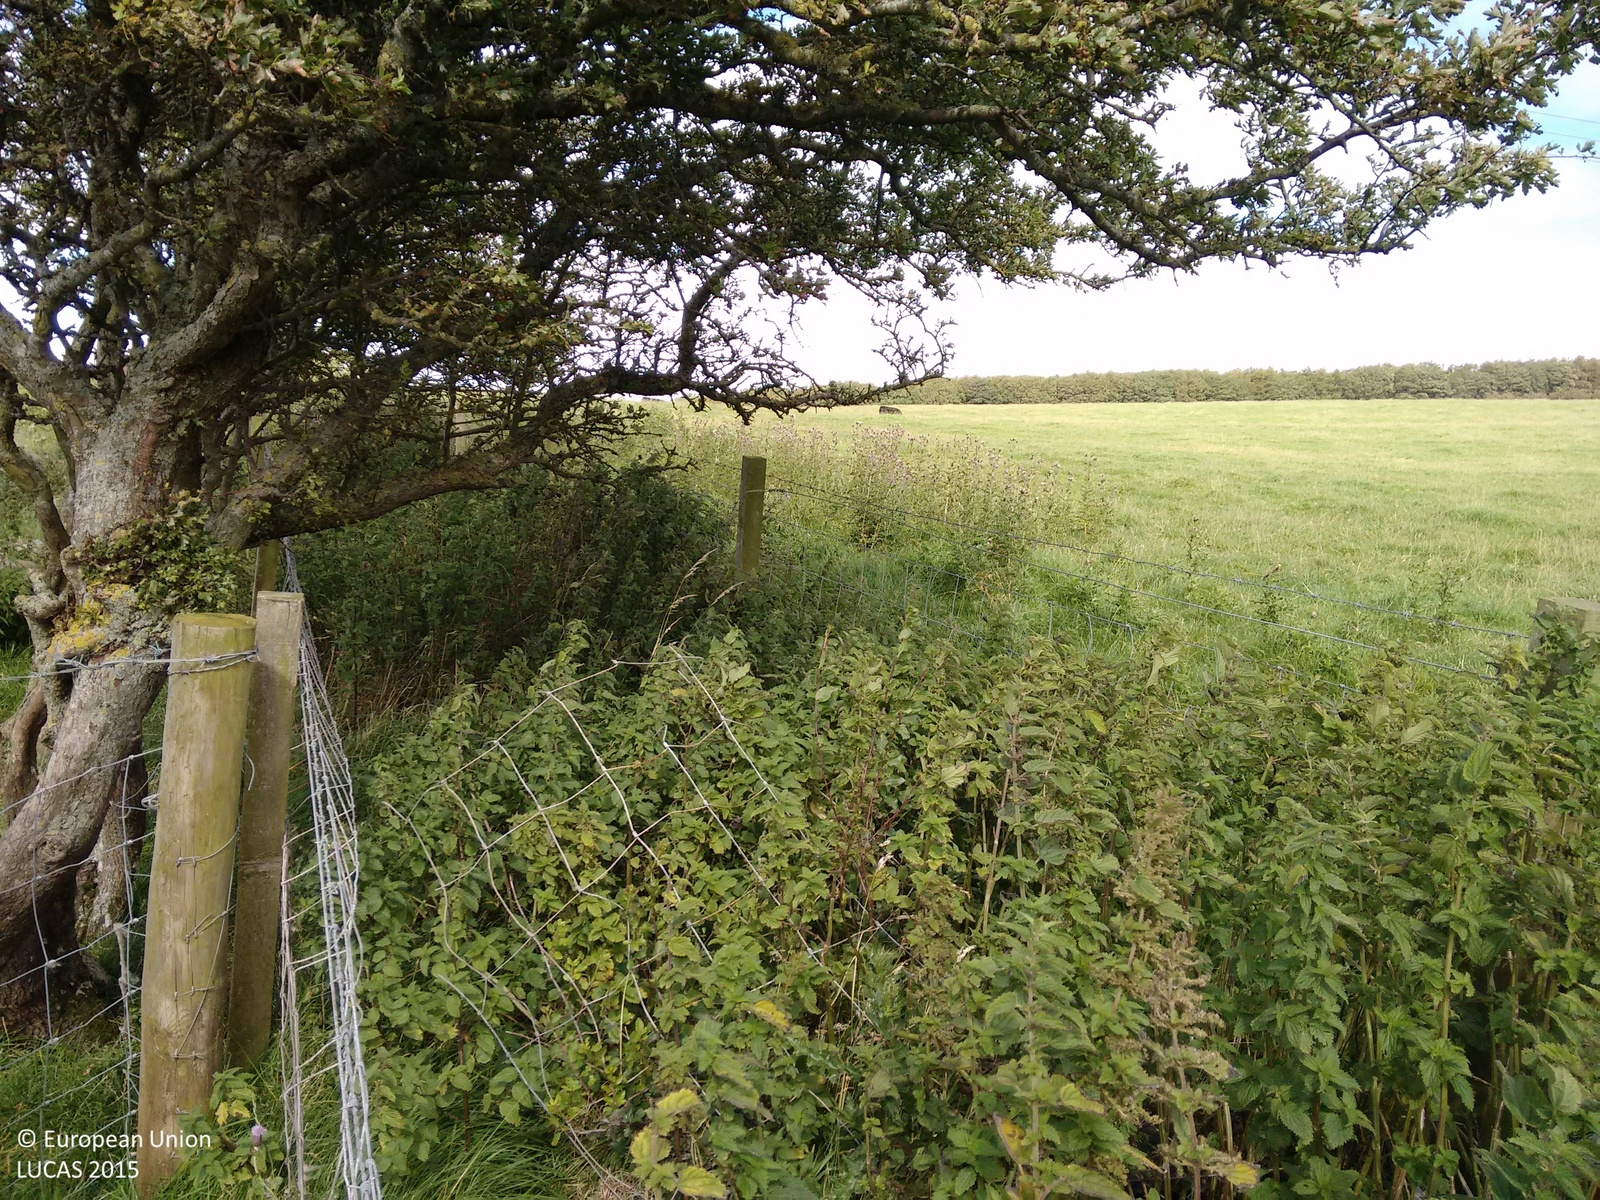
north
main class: Grassland
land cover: Grassland without tree/shrub cover
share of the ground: > 75 %
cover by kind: herbaceous plants 100 %
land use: Agriculture (excluding fallow land and kitchen gardens)
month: August
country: GB
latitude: 55.3213
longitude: -4.8114
